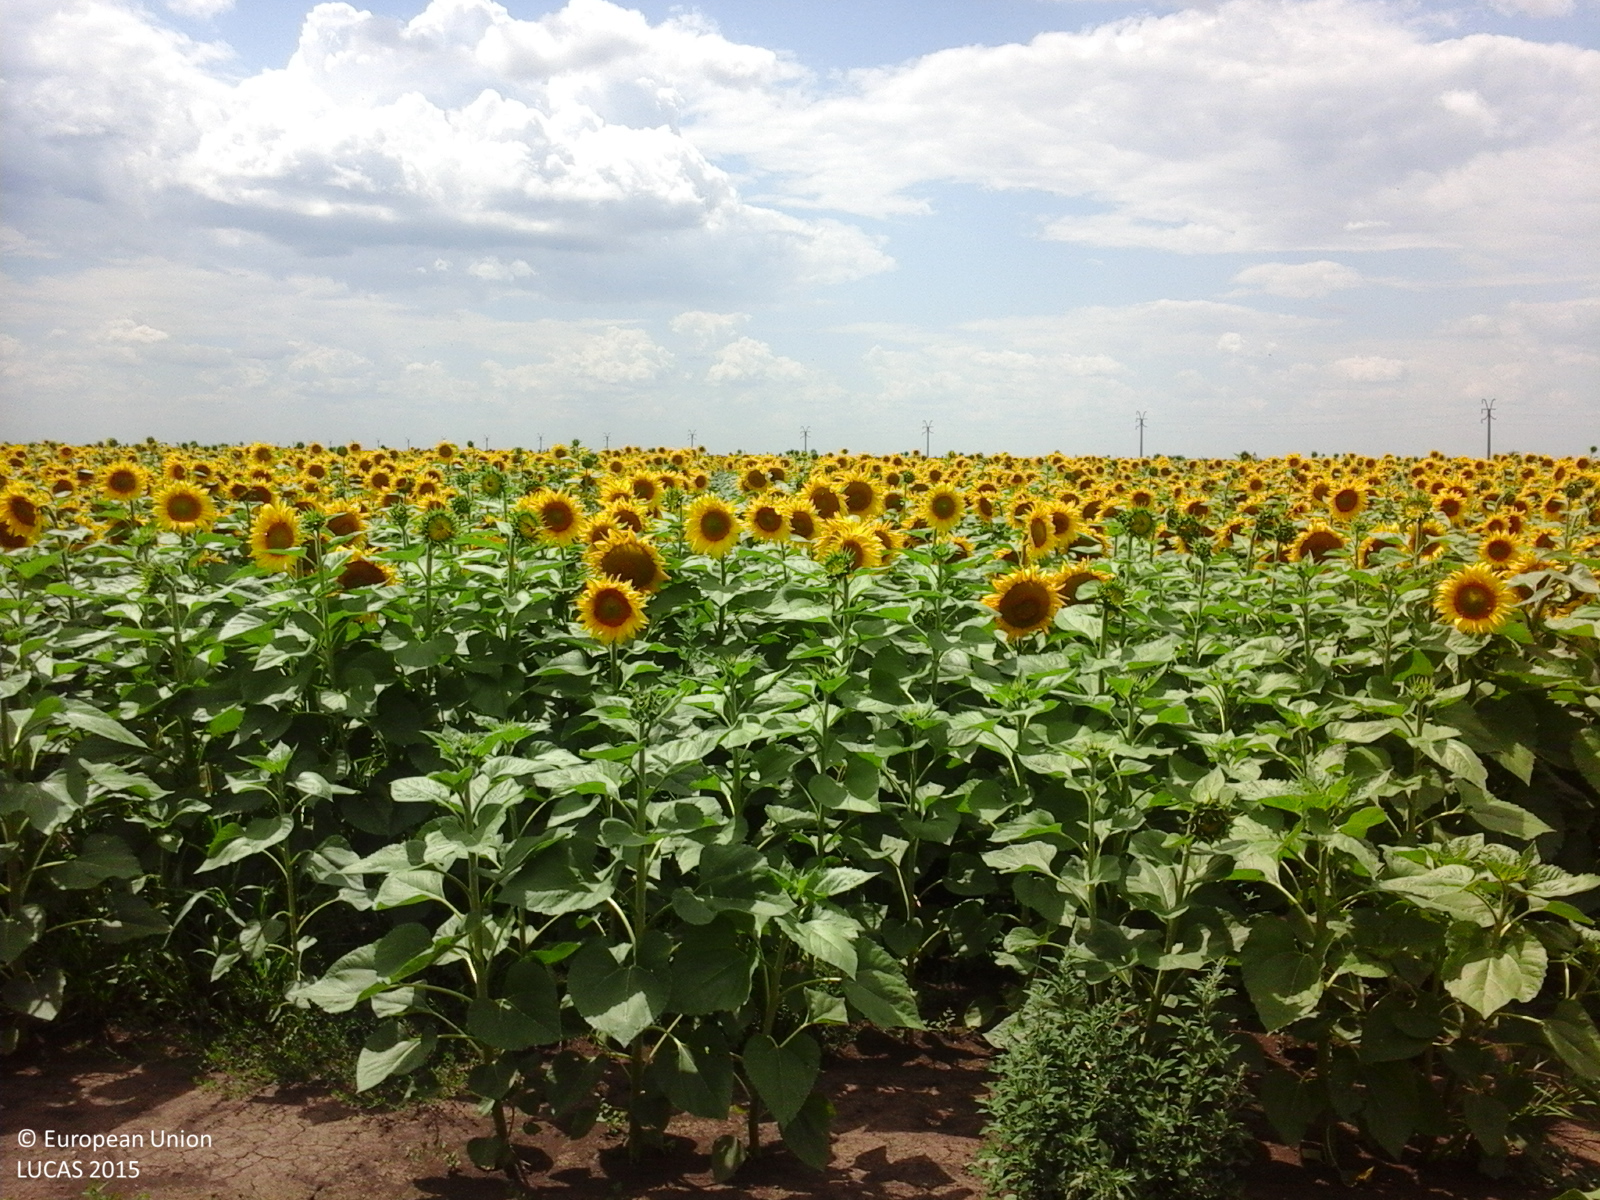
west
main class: Cropland
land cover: Sunflower
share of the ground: > 75 %
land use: Agriculture (excluding fallow land and kitchen gardens)
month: July
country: RO
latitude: 44.0389
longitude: 24.8870
